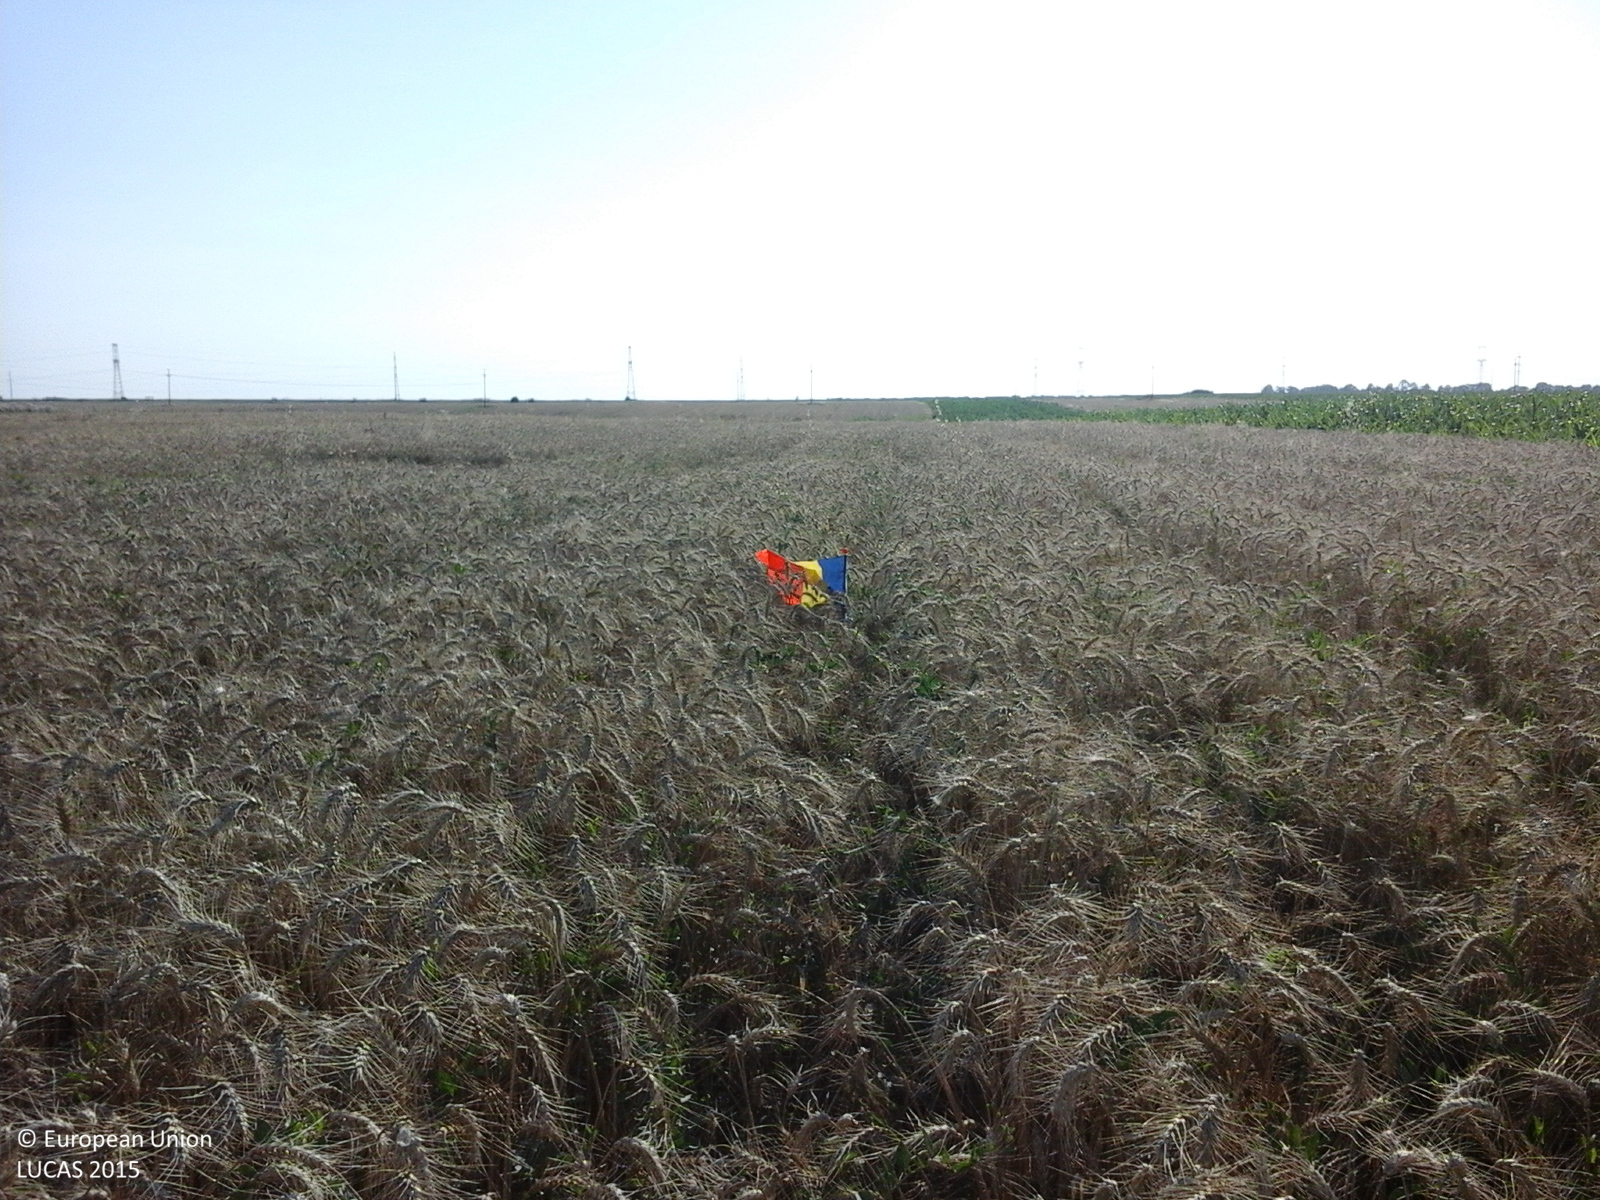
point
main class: Cropland
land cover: Common wheat
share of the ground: > 75 %
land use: Agriculture (excluding fallow land and kitchen gardens)
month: July
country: RO
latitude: 44.3210
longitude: 24.4504
